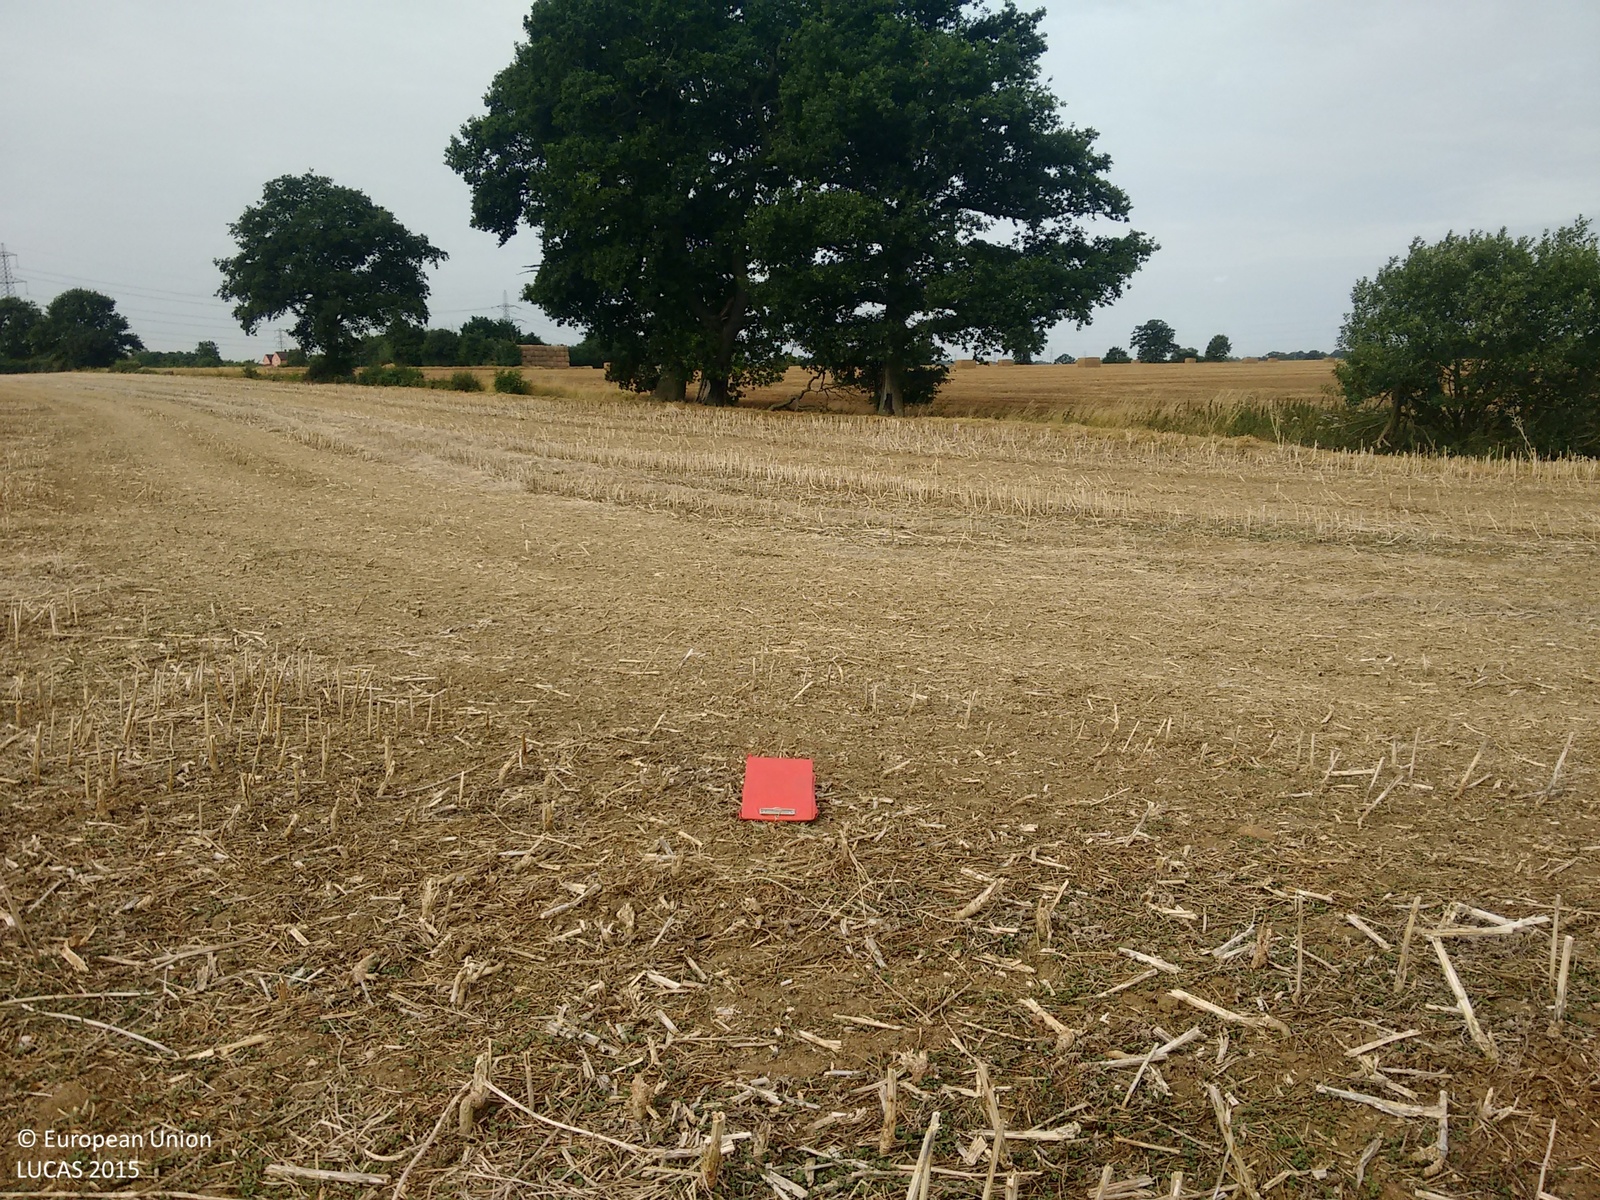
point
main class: Cropland
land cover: Rape and turnip rape
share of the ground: < 10 %
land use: Agriculture (excluding fallow land and kitchen gardens)
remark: Harvested field
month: August
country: GB
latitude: 52.0043
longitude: 0.6065
